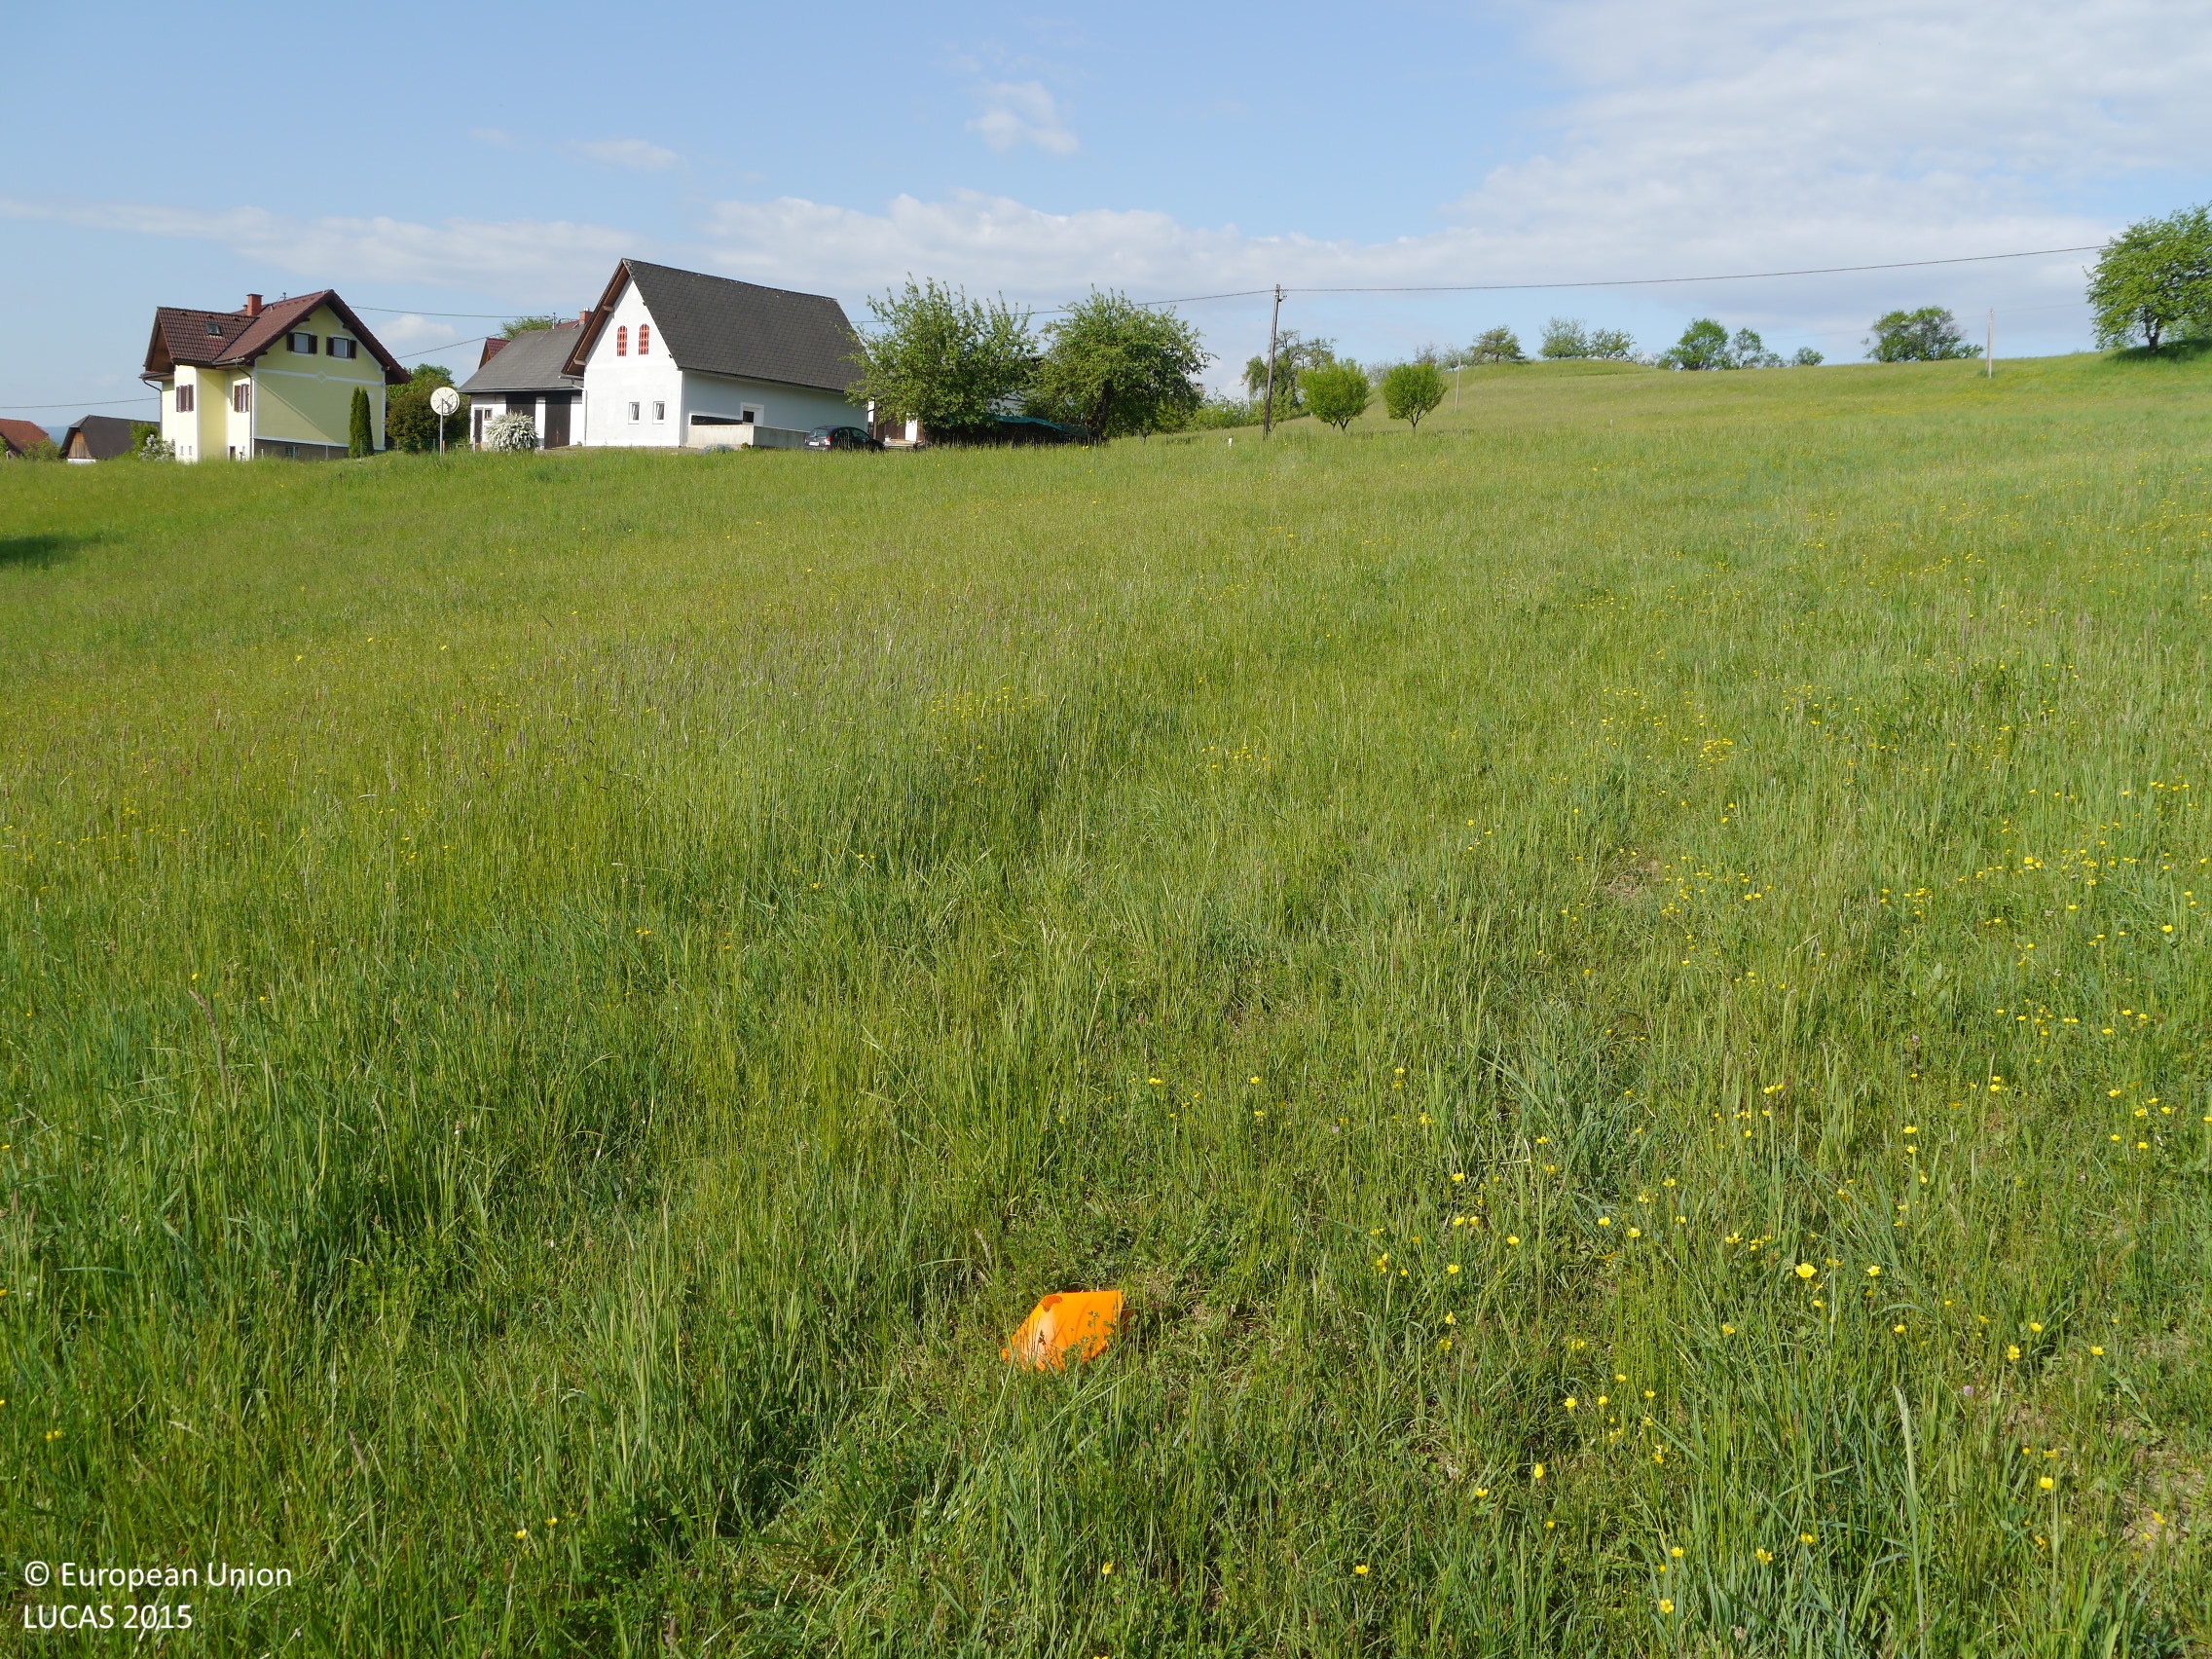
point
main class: Grassland
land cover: Grassland without tree/shrub cover
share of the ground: > 75 %
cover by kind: herbaceous plants 100 %
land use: Agriculture (excluding fallow land and kitchen gardens)
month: May
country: AT
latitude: 47.0331
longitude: 15.2763
